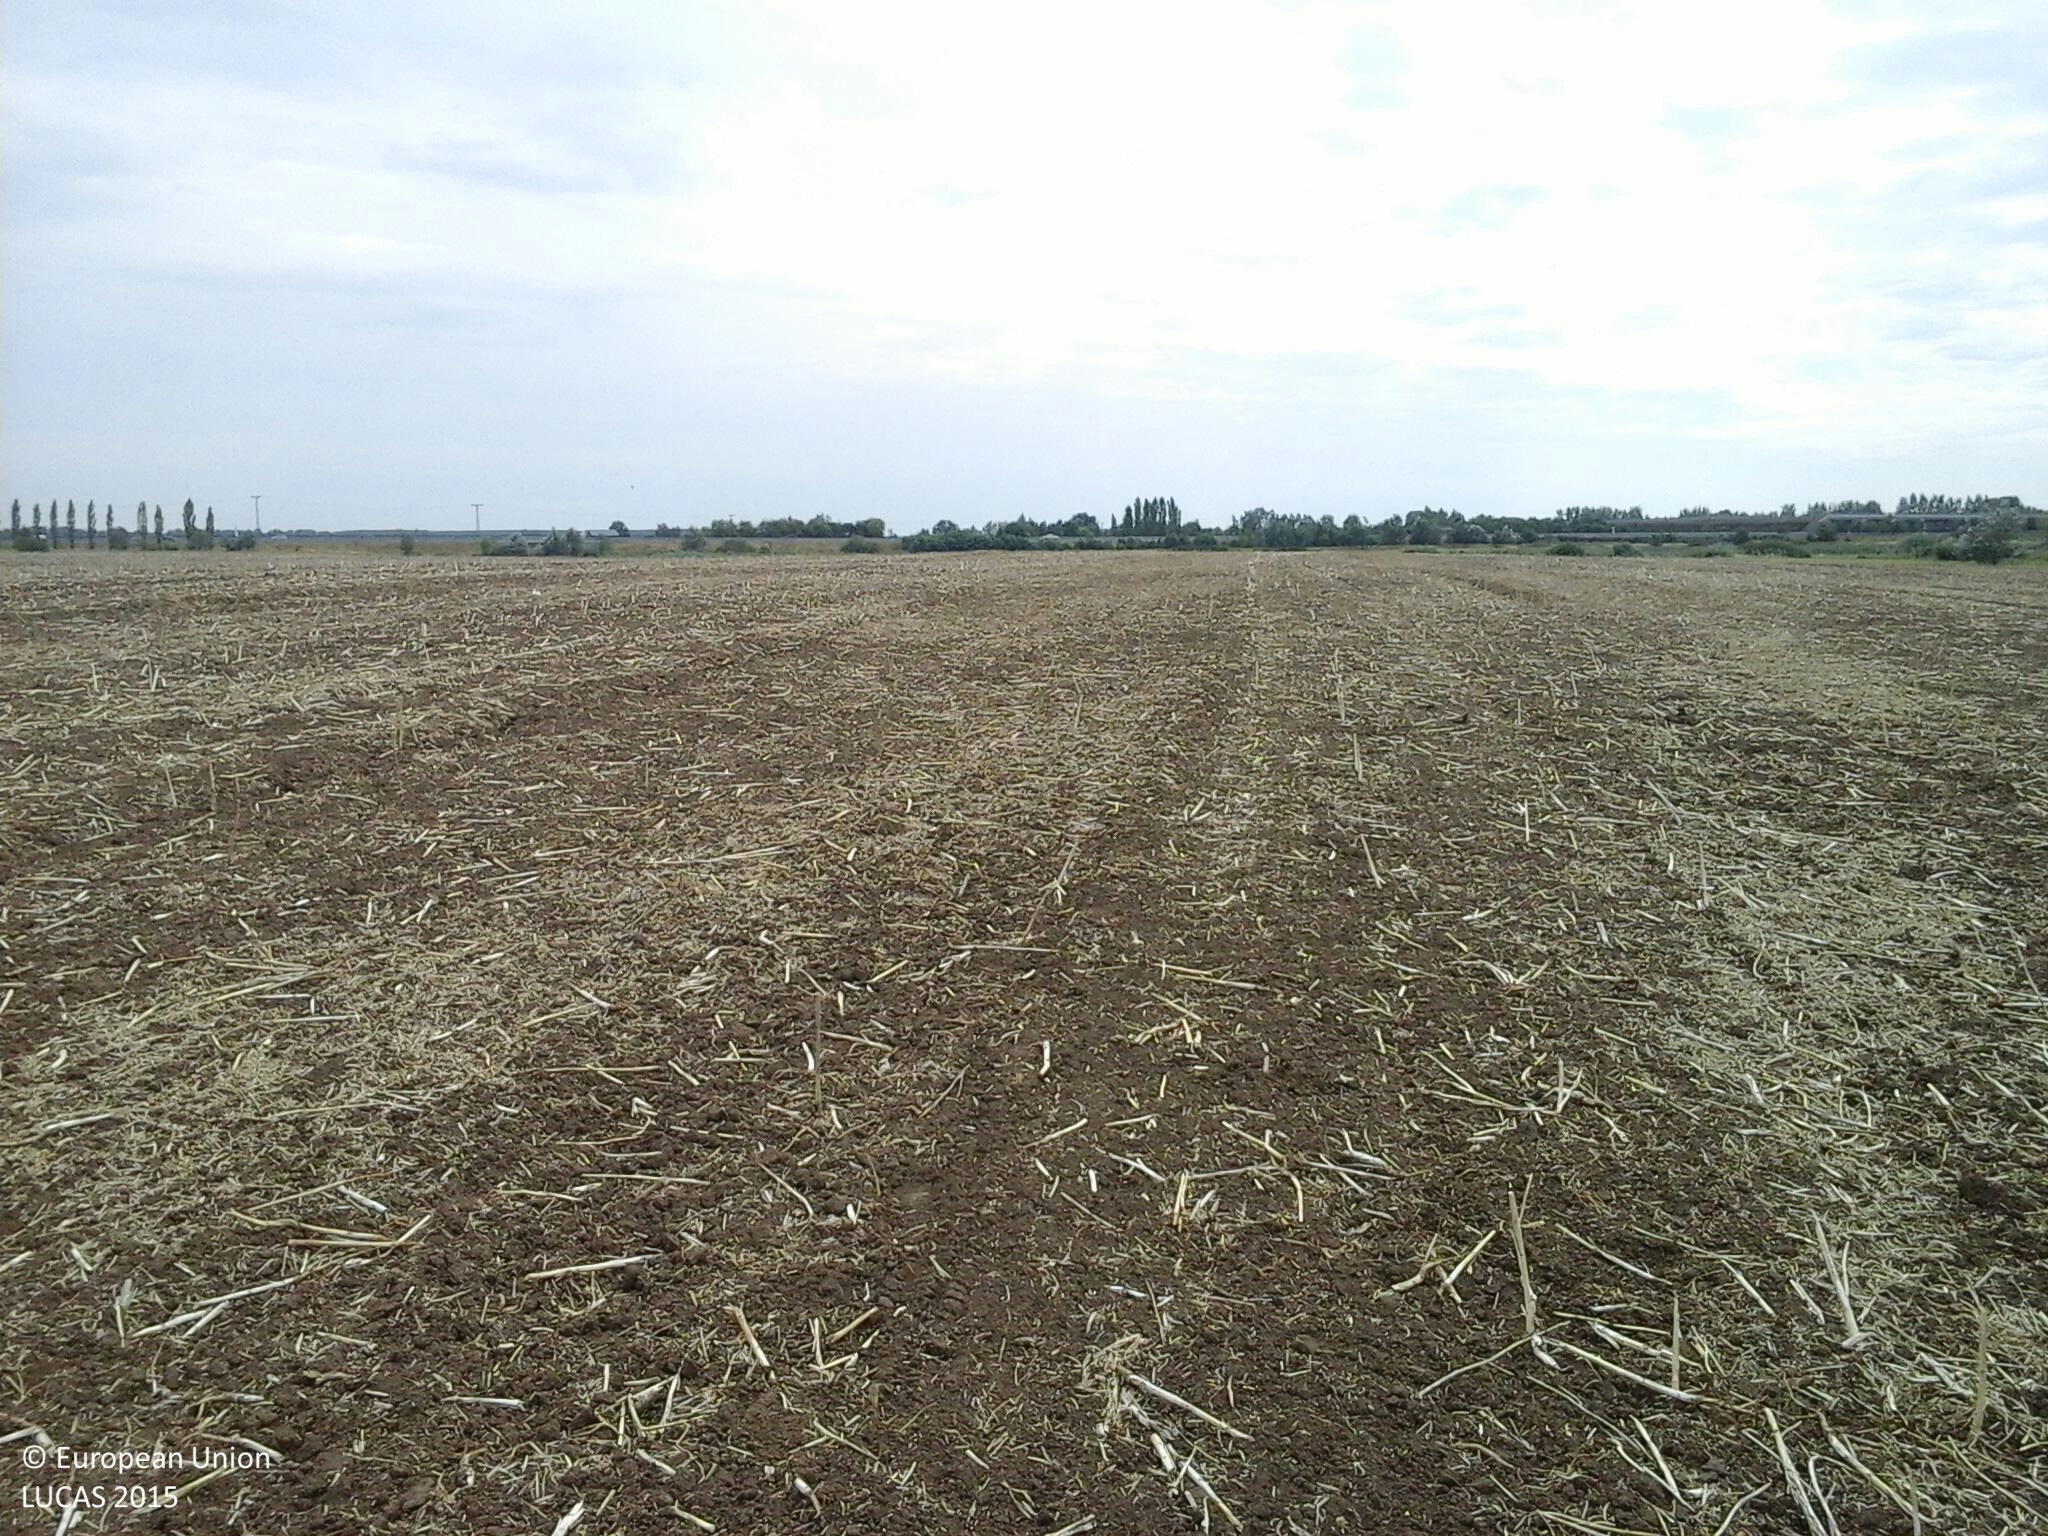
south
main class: Cropland
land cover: Rape and turnip rape
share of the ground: 25 - 50 %
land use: Agriculture (excluding fallow land and kitchen gardens)
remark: Harvested field
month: July
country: HU
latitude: 47.8696
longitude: 21.0144
